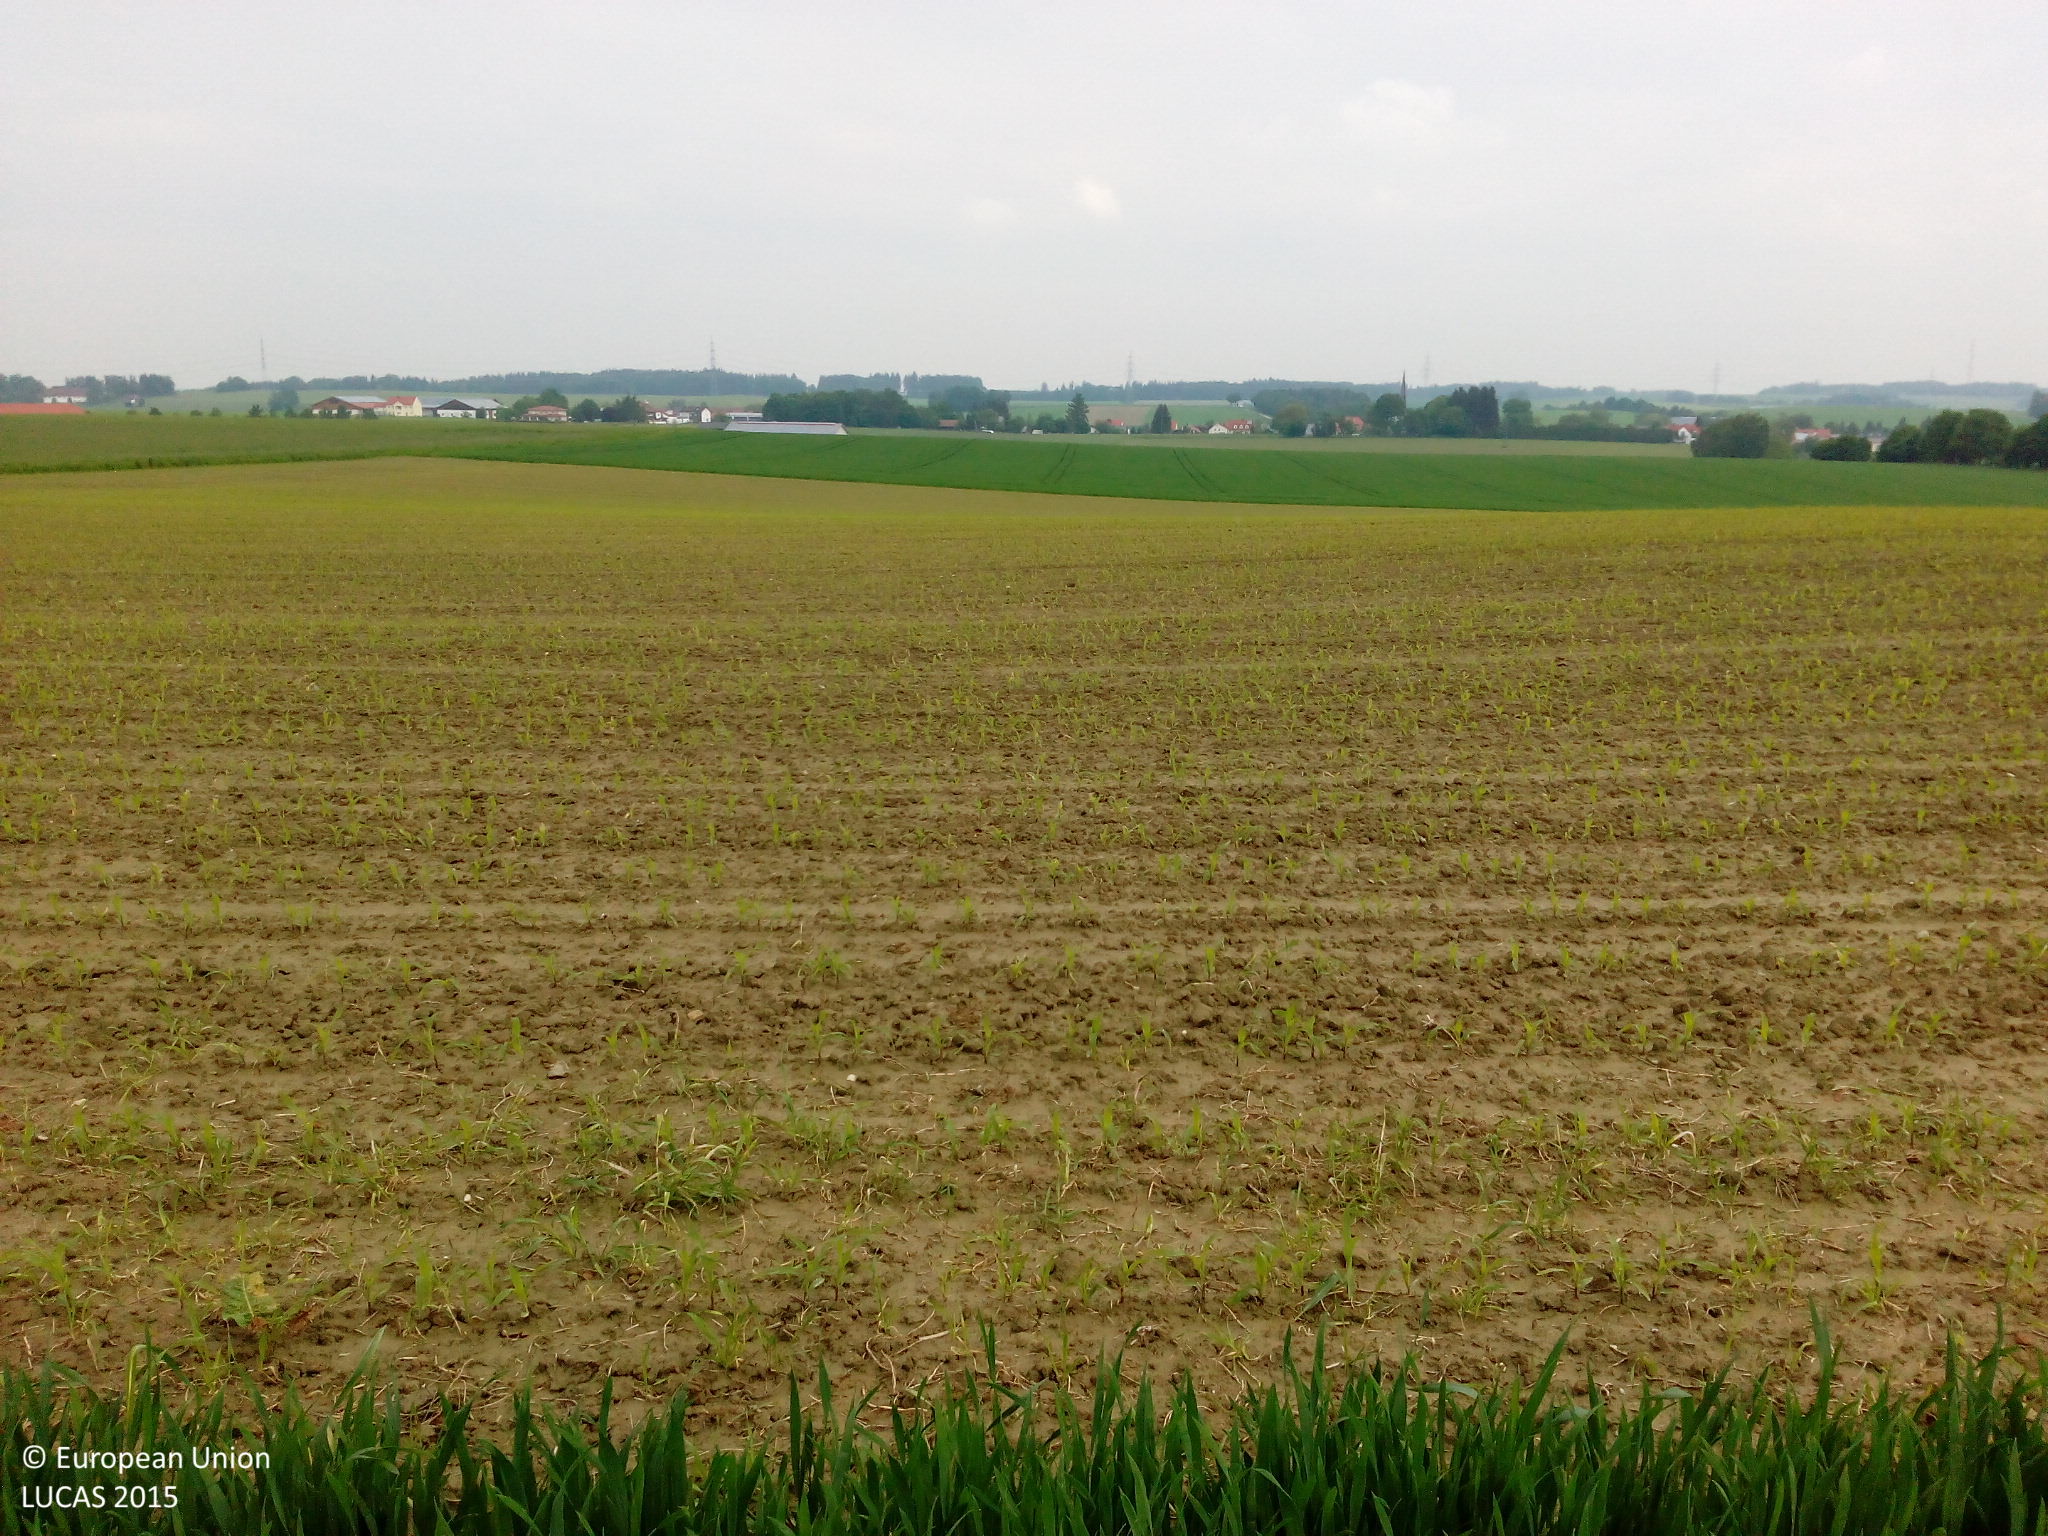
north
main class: Cropland
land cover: Common wheat
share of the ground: > 75 %
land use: Agriculture (excluding fallow land and kitchen gardens)
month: May
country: DE
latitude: 48.2865
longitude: 11.4143
